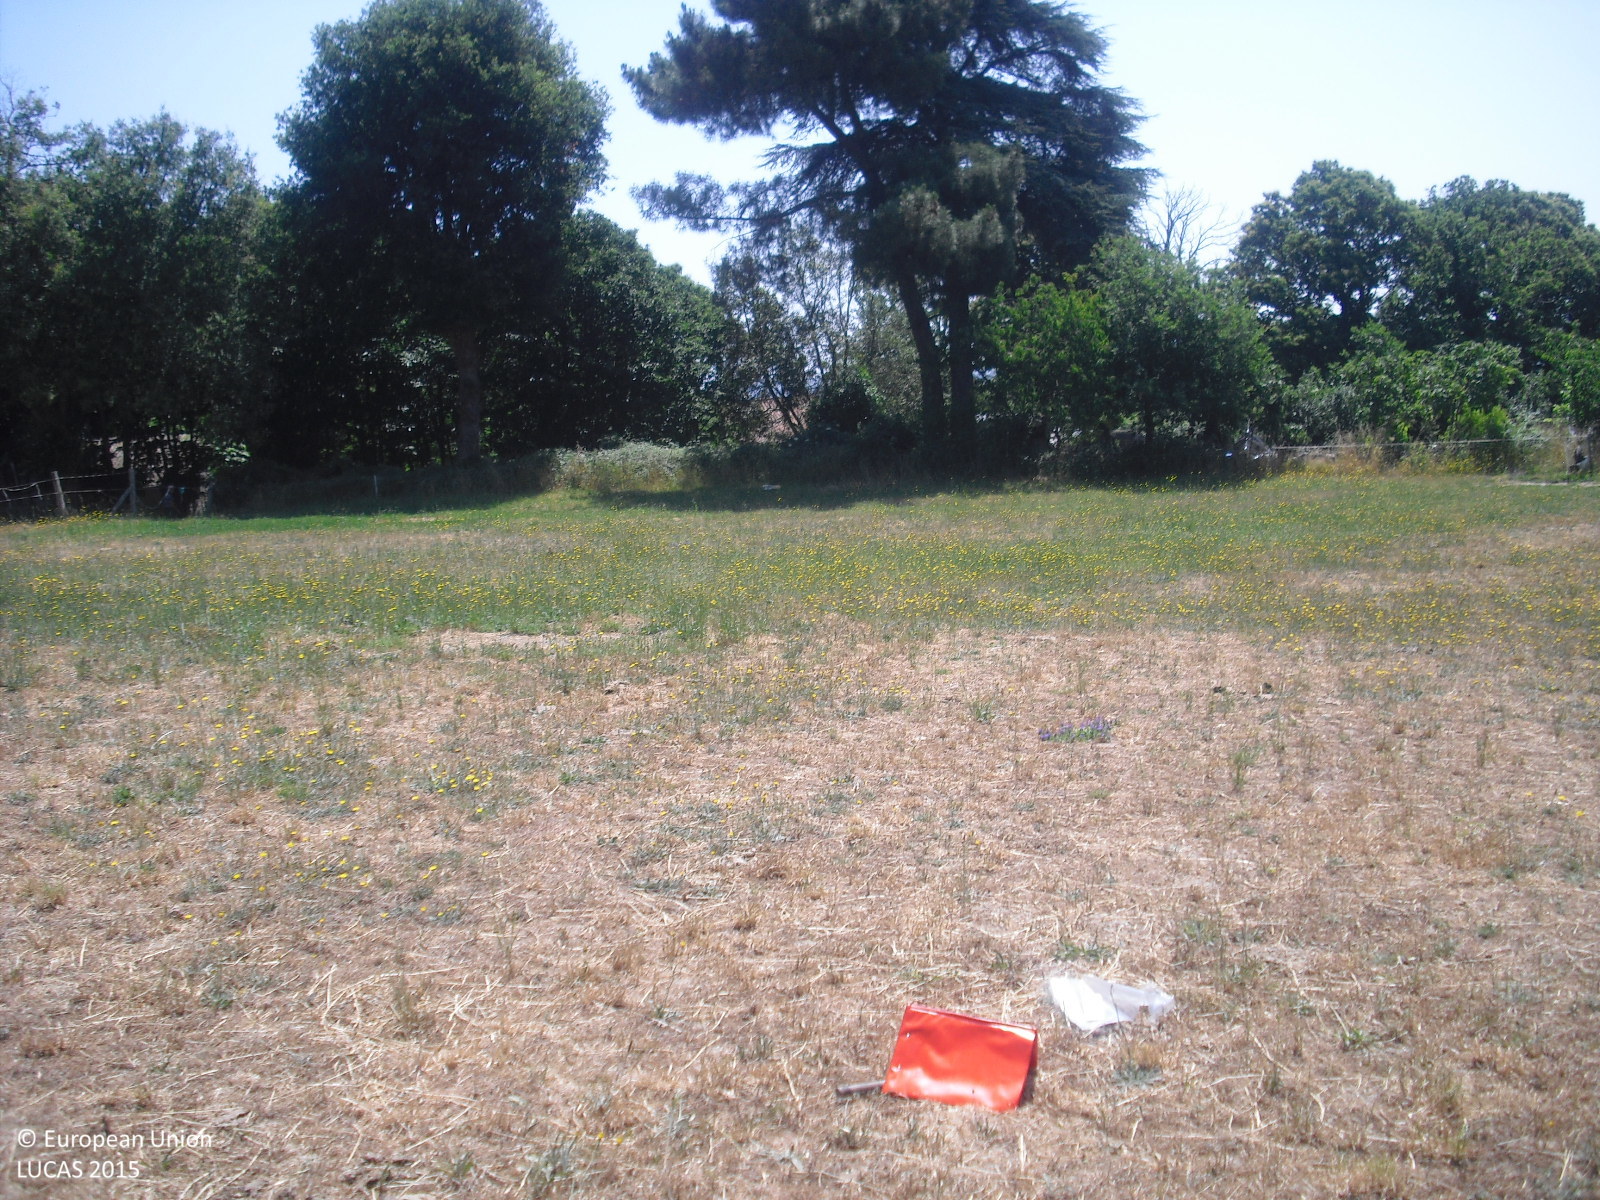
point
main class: Cropland
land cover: Temporary grasslands
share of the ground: > 75 %
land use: Agriculture (excluding fallow land and kitchen gardens)
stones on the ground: 25 - 50 %
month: June
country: ES
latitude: 42.6176
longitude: -7.7678
